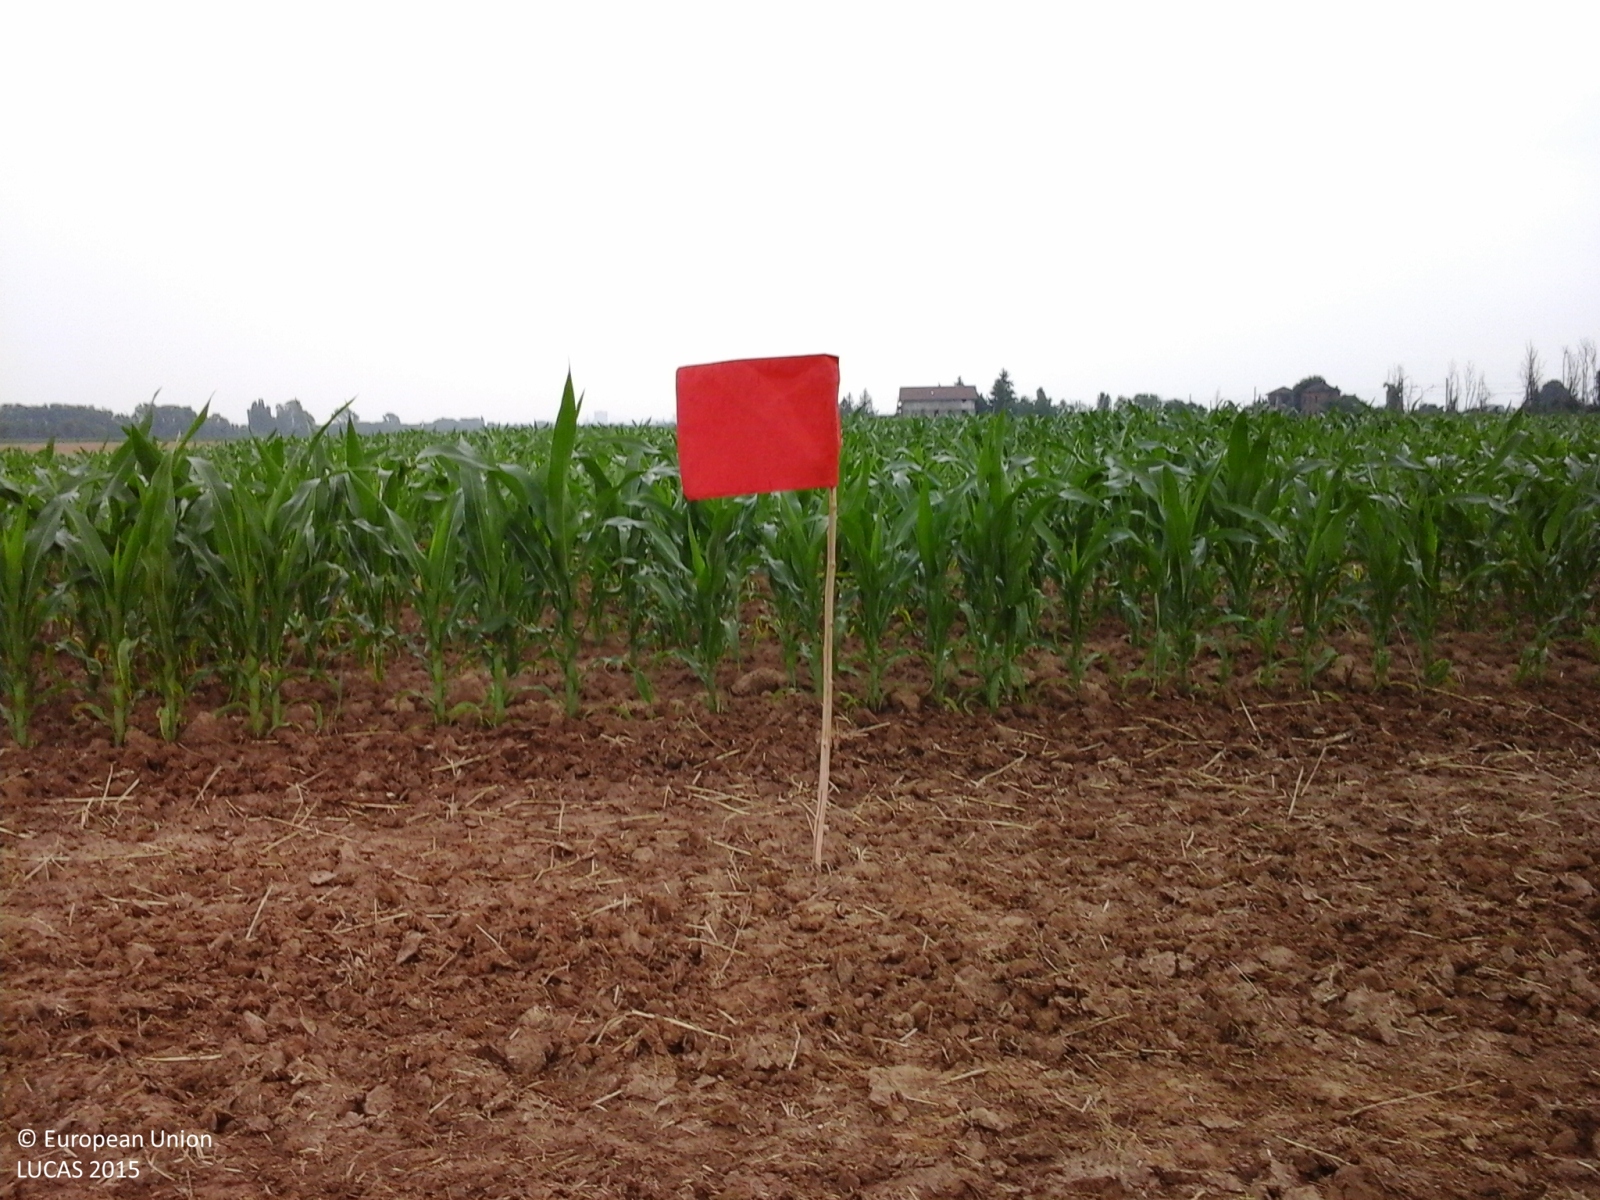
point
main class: Cropland
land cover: Maize
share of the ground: < 10 %
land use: Agriculture (excluding fallow land and kitchen gardens)
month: June
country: IT
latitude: 44.8117
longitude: 8.7255
